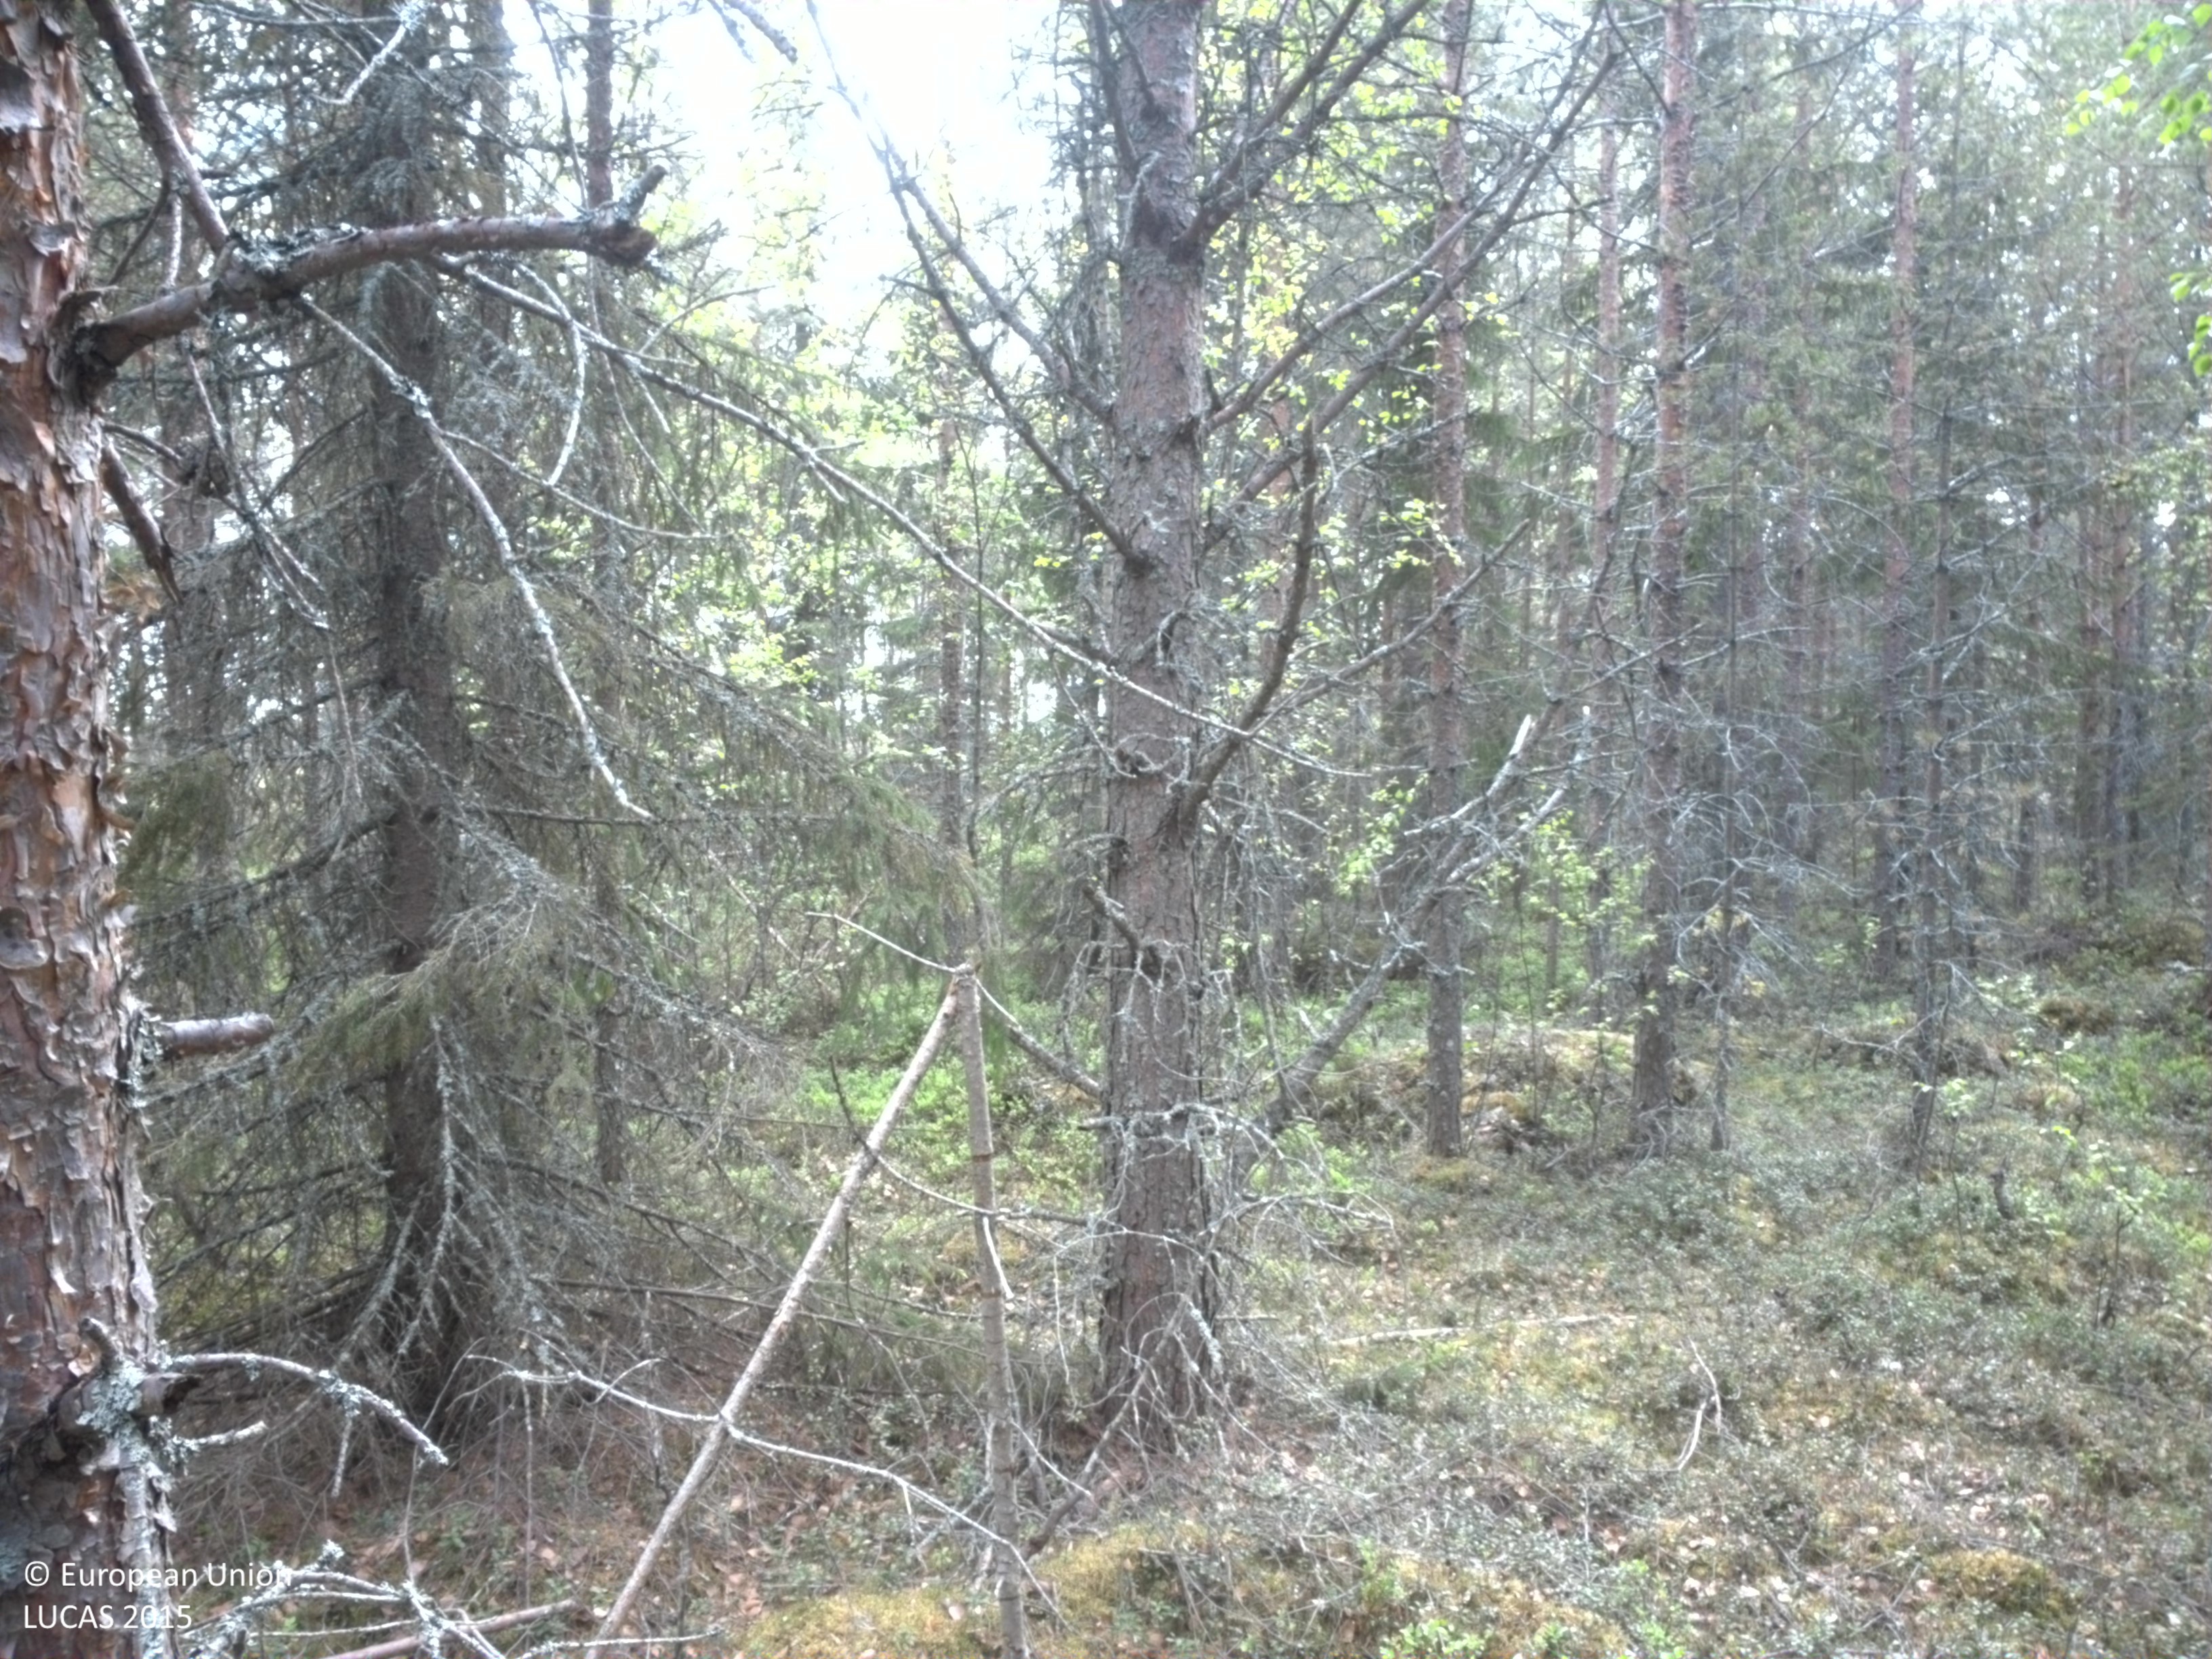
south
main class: Woodland
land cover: Pine dominated coniferous woodland
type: boreal forest
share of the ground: 50 - 75 %
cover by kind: coniferous forest trees 65 %, shrubs 20 %, broadleaved forest trees 10 %, lichens and mosses 5 %
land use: Forestry
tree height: > 5 m
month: June
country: SE
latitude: 63.9652
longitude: 20.6633
